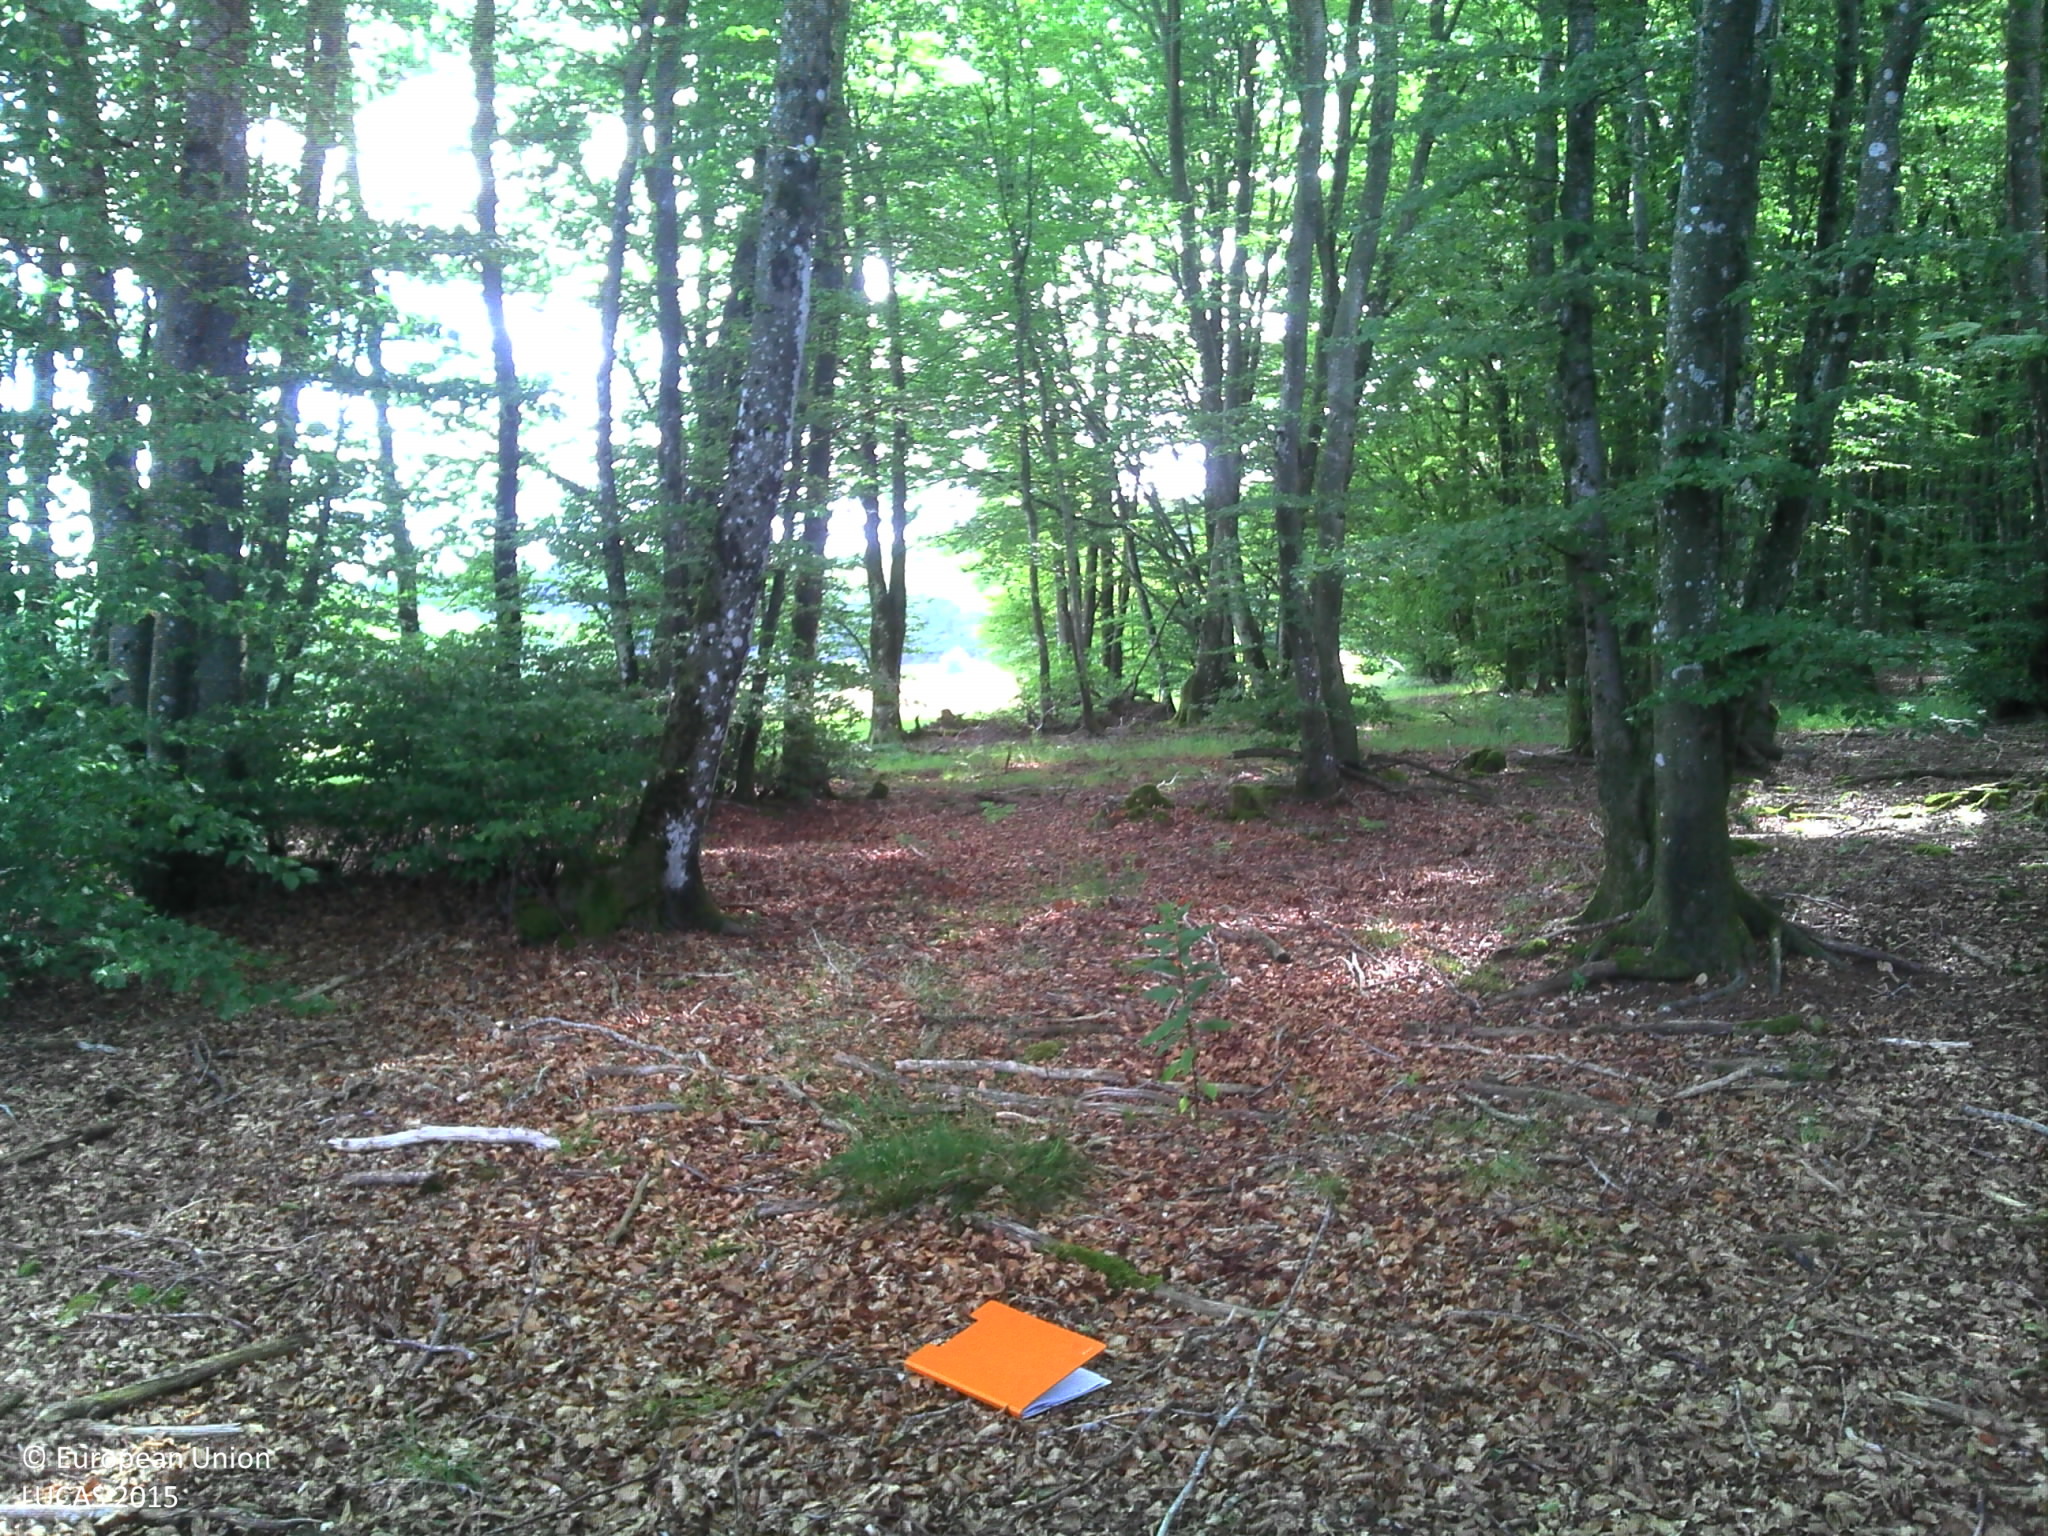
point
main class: Woodland
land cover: Spruce dominated mixed woodland
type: hemiboreal forest and nemoral coniferous forest and mixed broadleaved-coniferous forest
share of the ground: > 75 %
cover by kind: broadleaved forest trees 65 %, coniferous forest trees 25 %, herbaceous plants 5 %, lichens and mosses 5 %
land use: Forestry
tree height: > 5 m
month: June
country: FR
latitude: 46.9588
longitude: 3.9936
